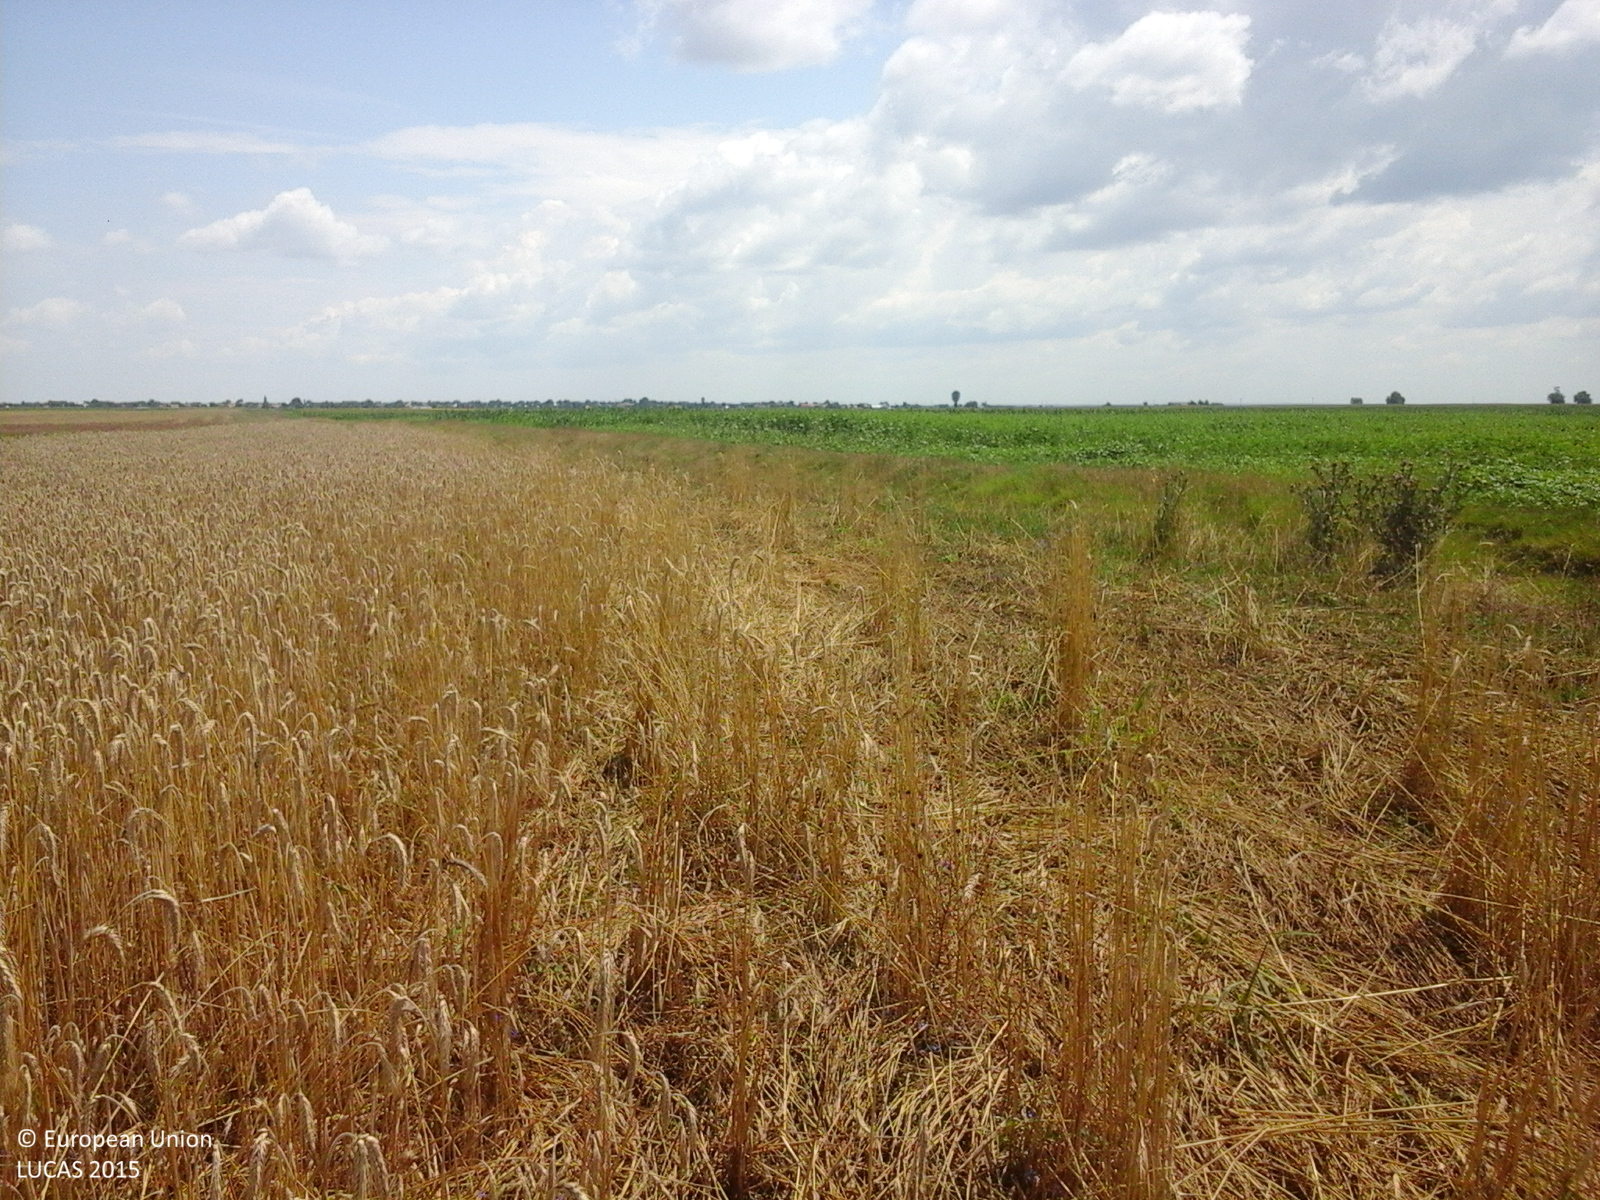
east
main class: Cropland
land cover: Rye
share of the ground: > 75 %
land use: Agriculture (excluding fallow land and kitchen gardens)
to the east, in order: Rye; Grass margins; Ditches and canals; Grass margins; Sunflower; Maize; Sunflower
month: July
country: RO
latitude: 44.0139
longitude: 24.4225
